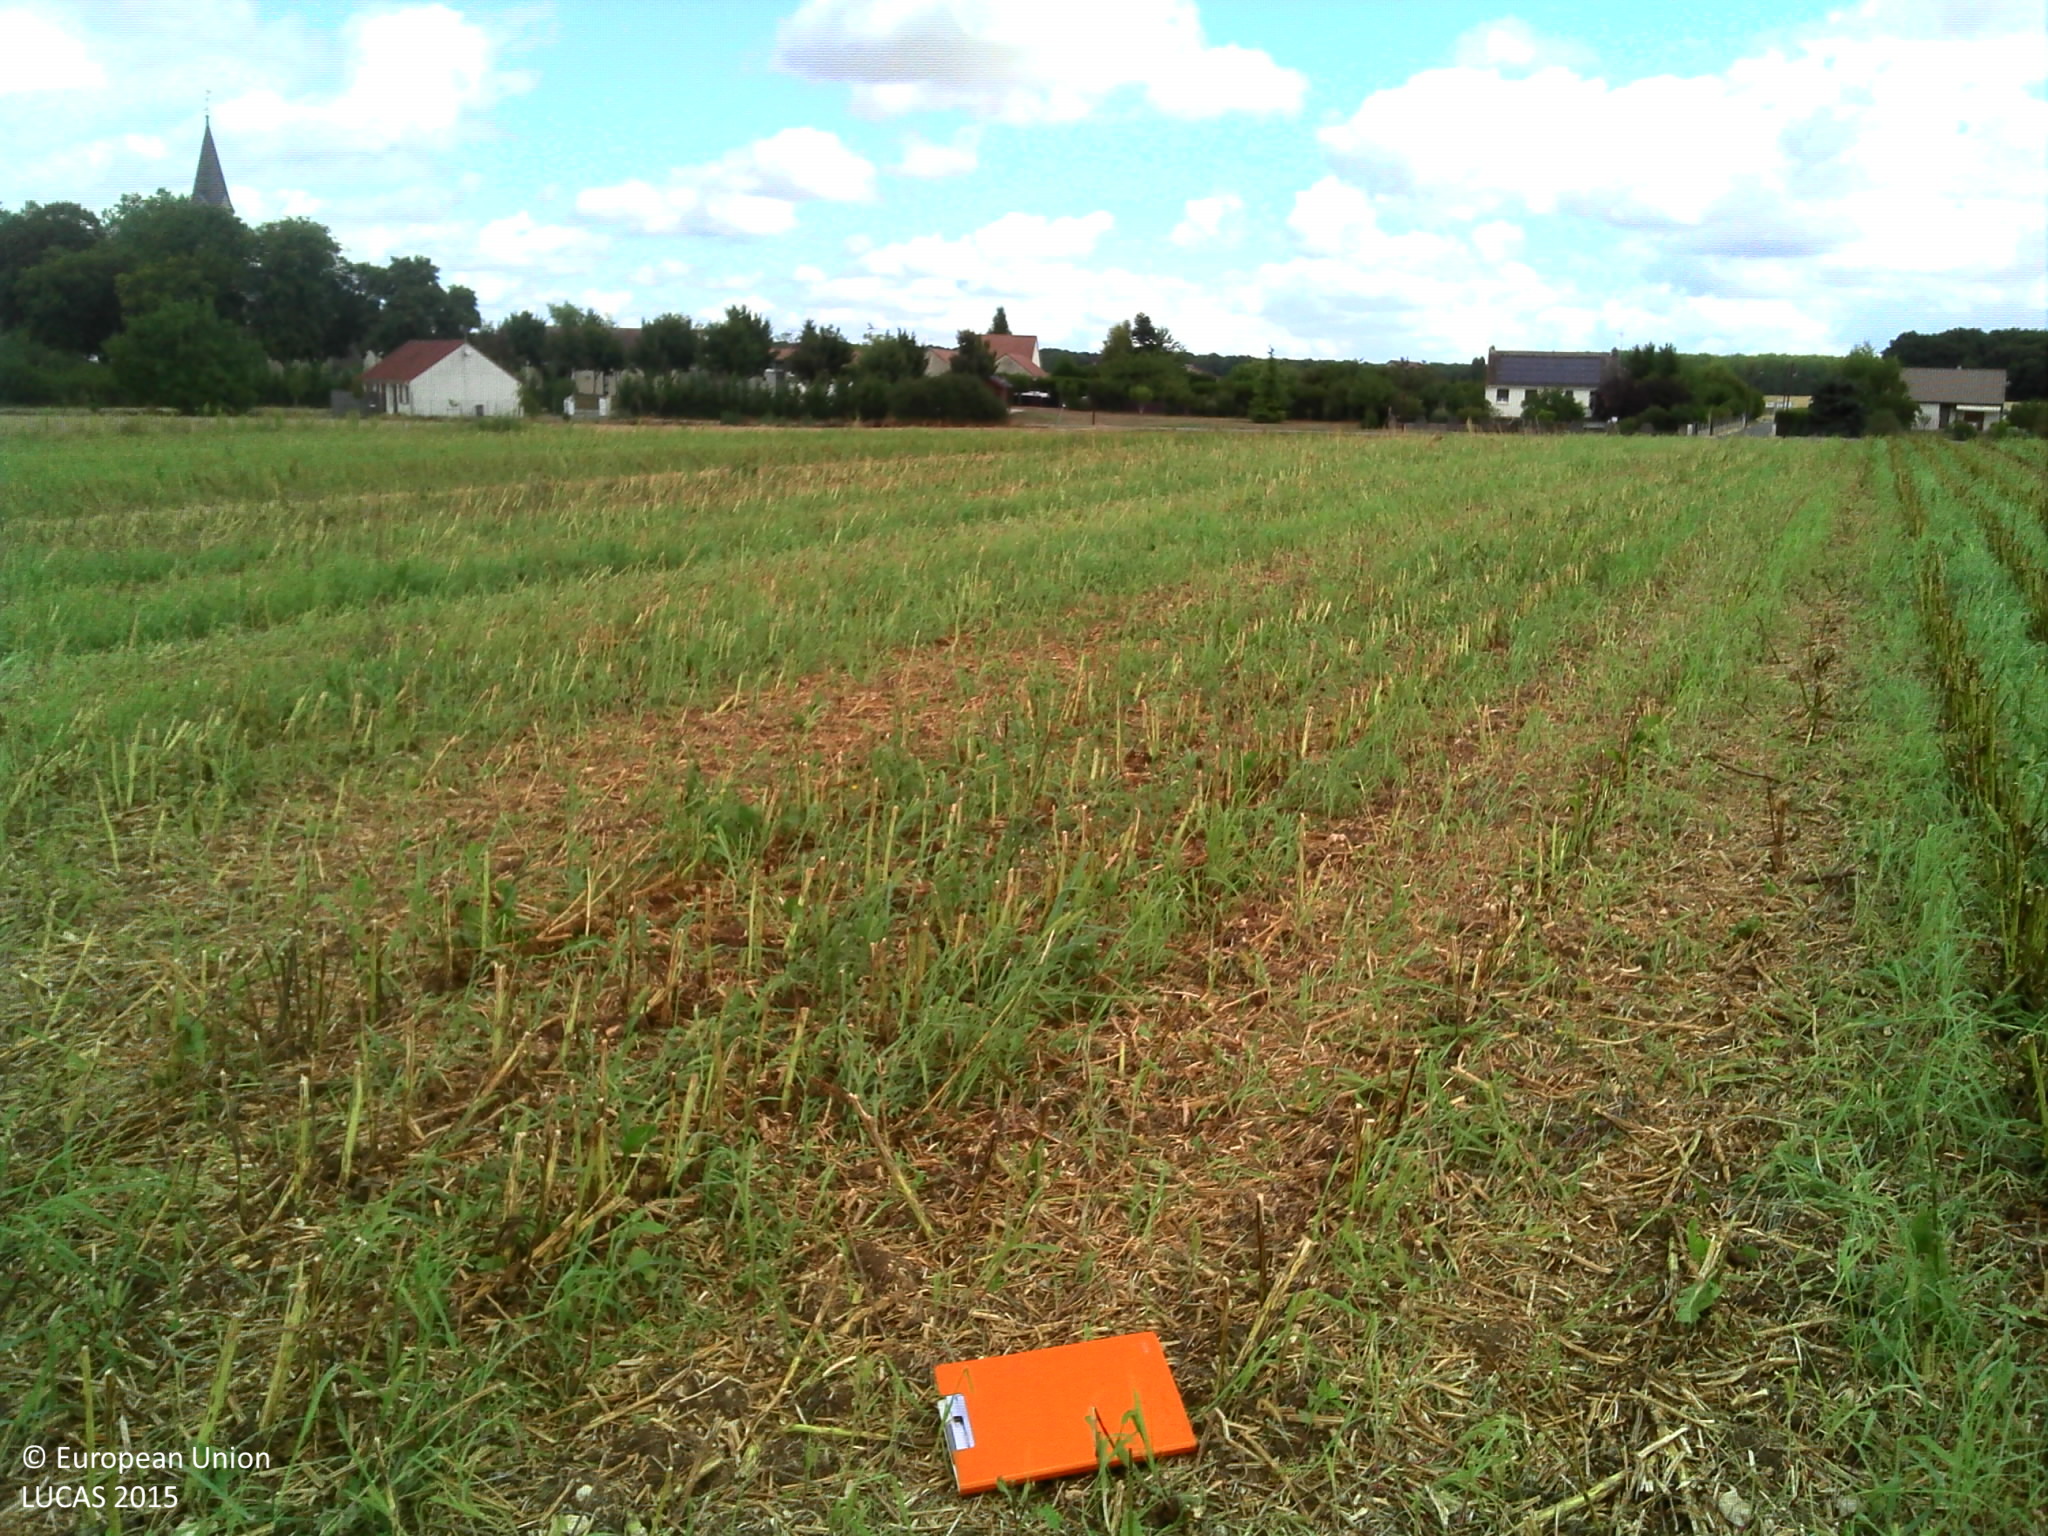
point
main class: Cropland
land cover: Rape and turnip rape
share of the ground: 25 - 50 %
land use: Agriculture (excluding fallow land and kitchen gardens)
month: August
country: FR
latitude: 47.1078
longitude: 2.0977
